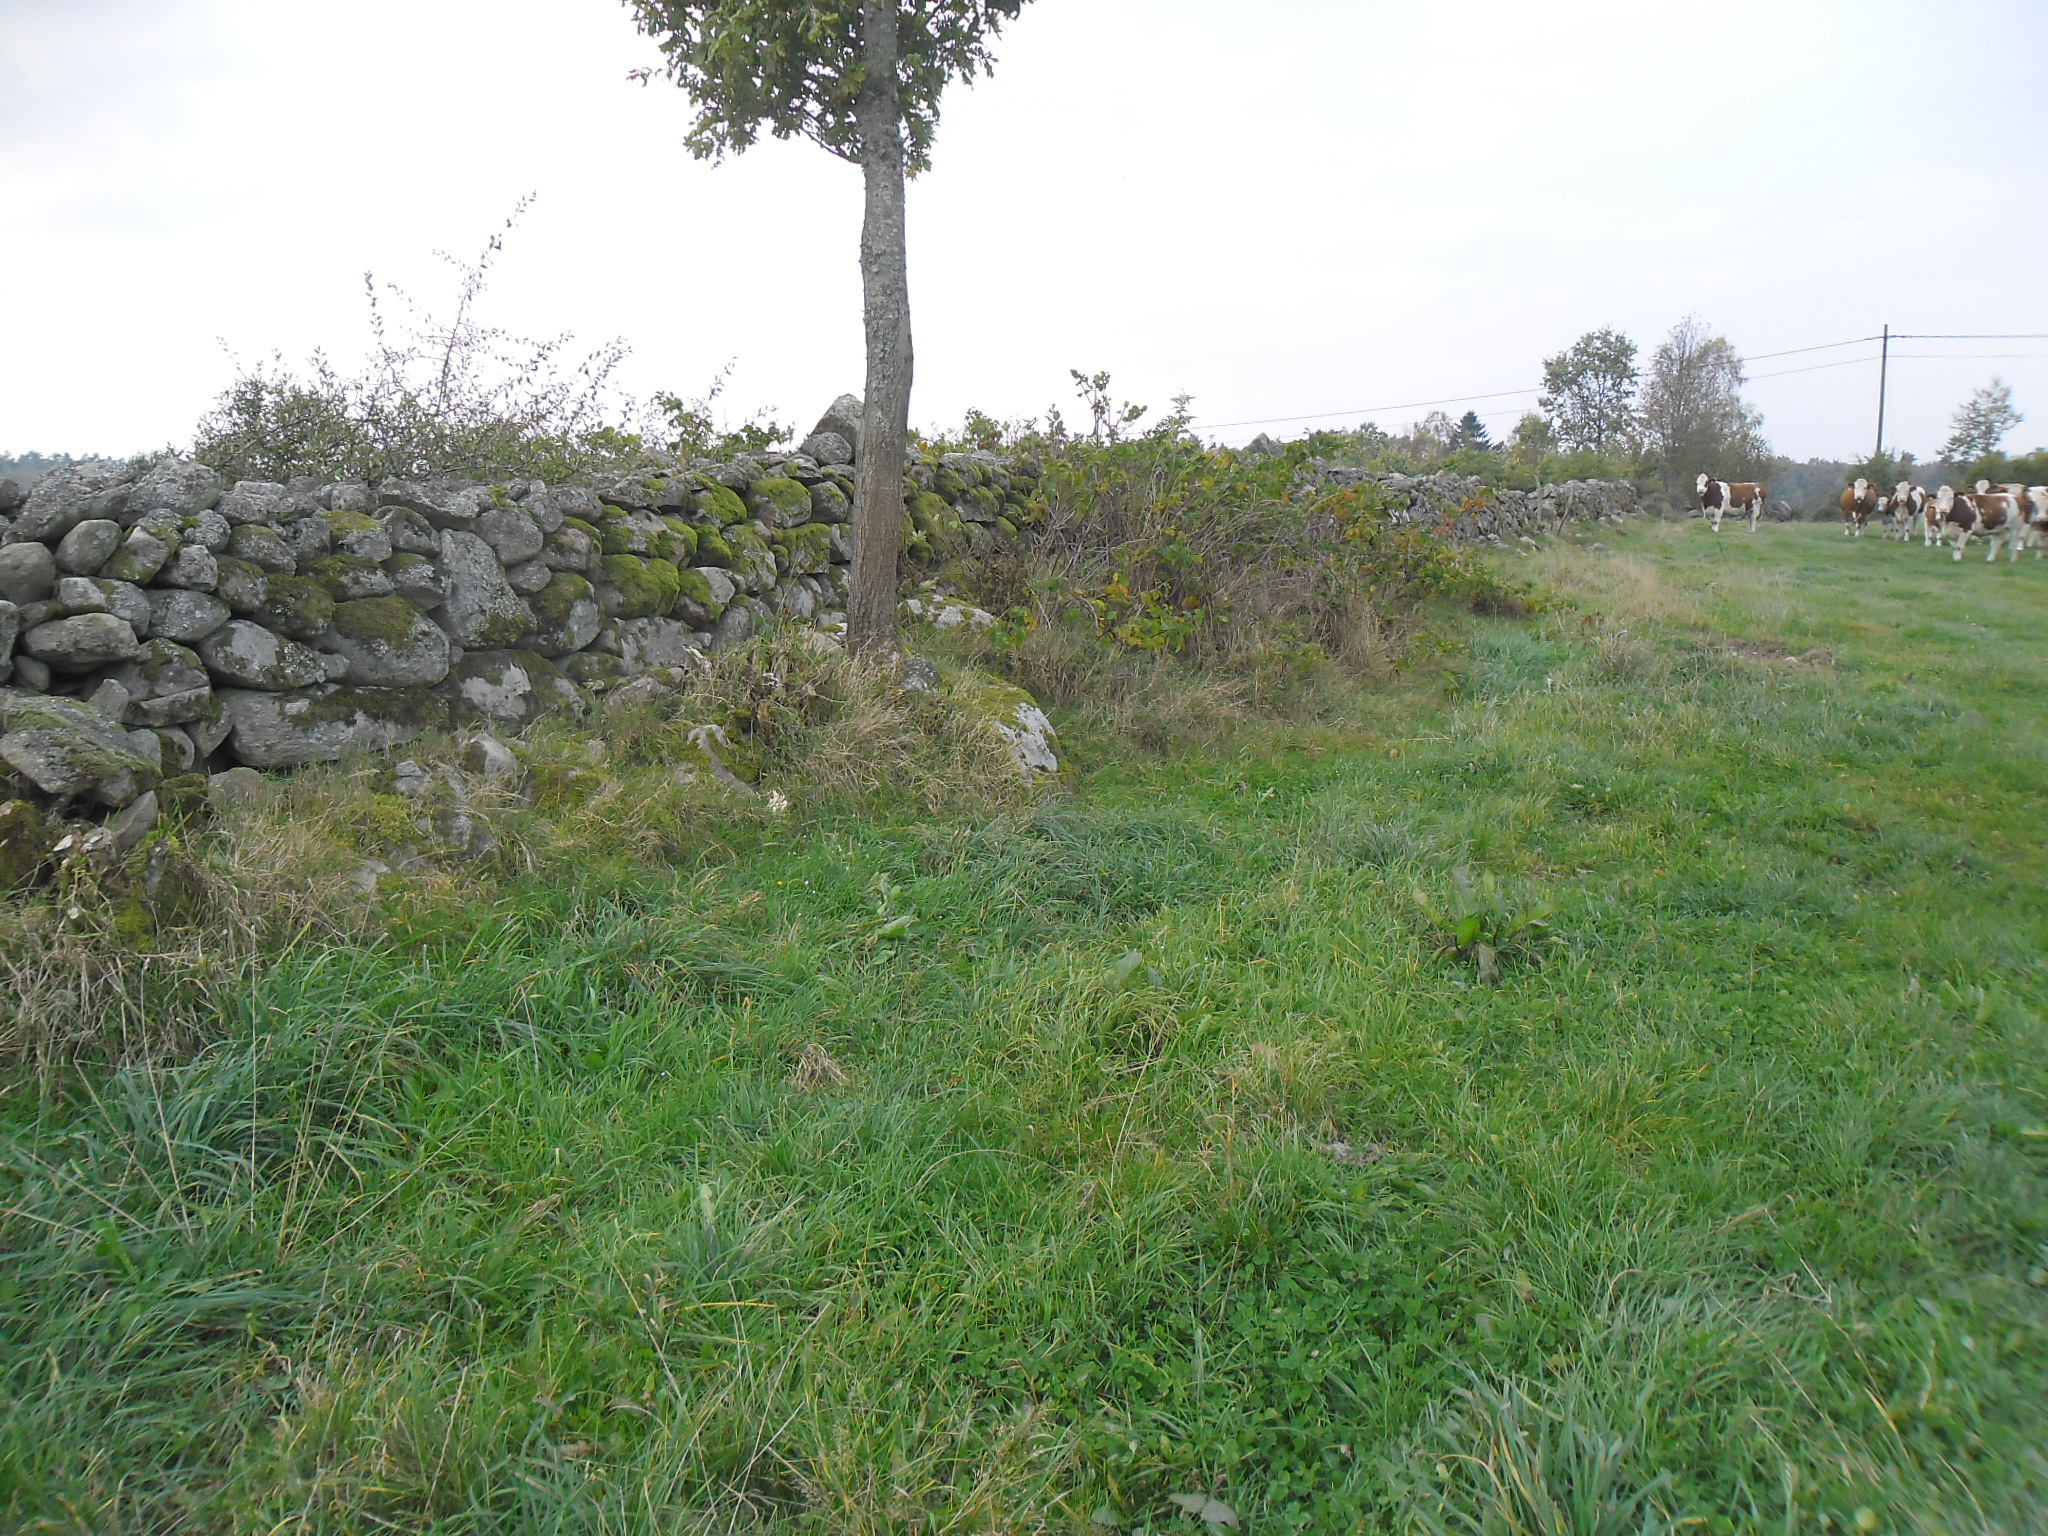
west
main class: Grassland
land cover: Grassland without tree/shrub cover
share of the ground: > 75 %
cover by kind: herbaceous plants 100 %
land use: Agriculture (excluding fallow land and kitchen gardens)
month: October
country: SE
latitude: 56.2597
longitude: 13.7265
